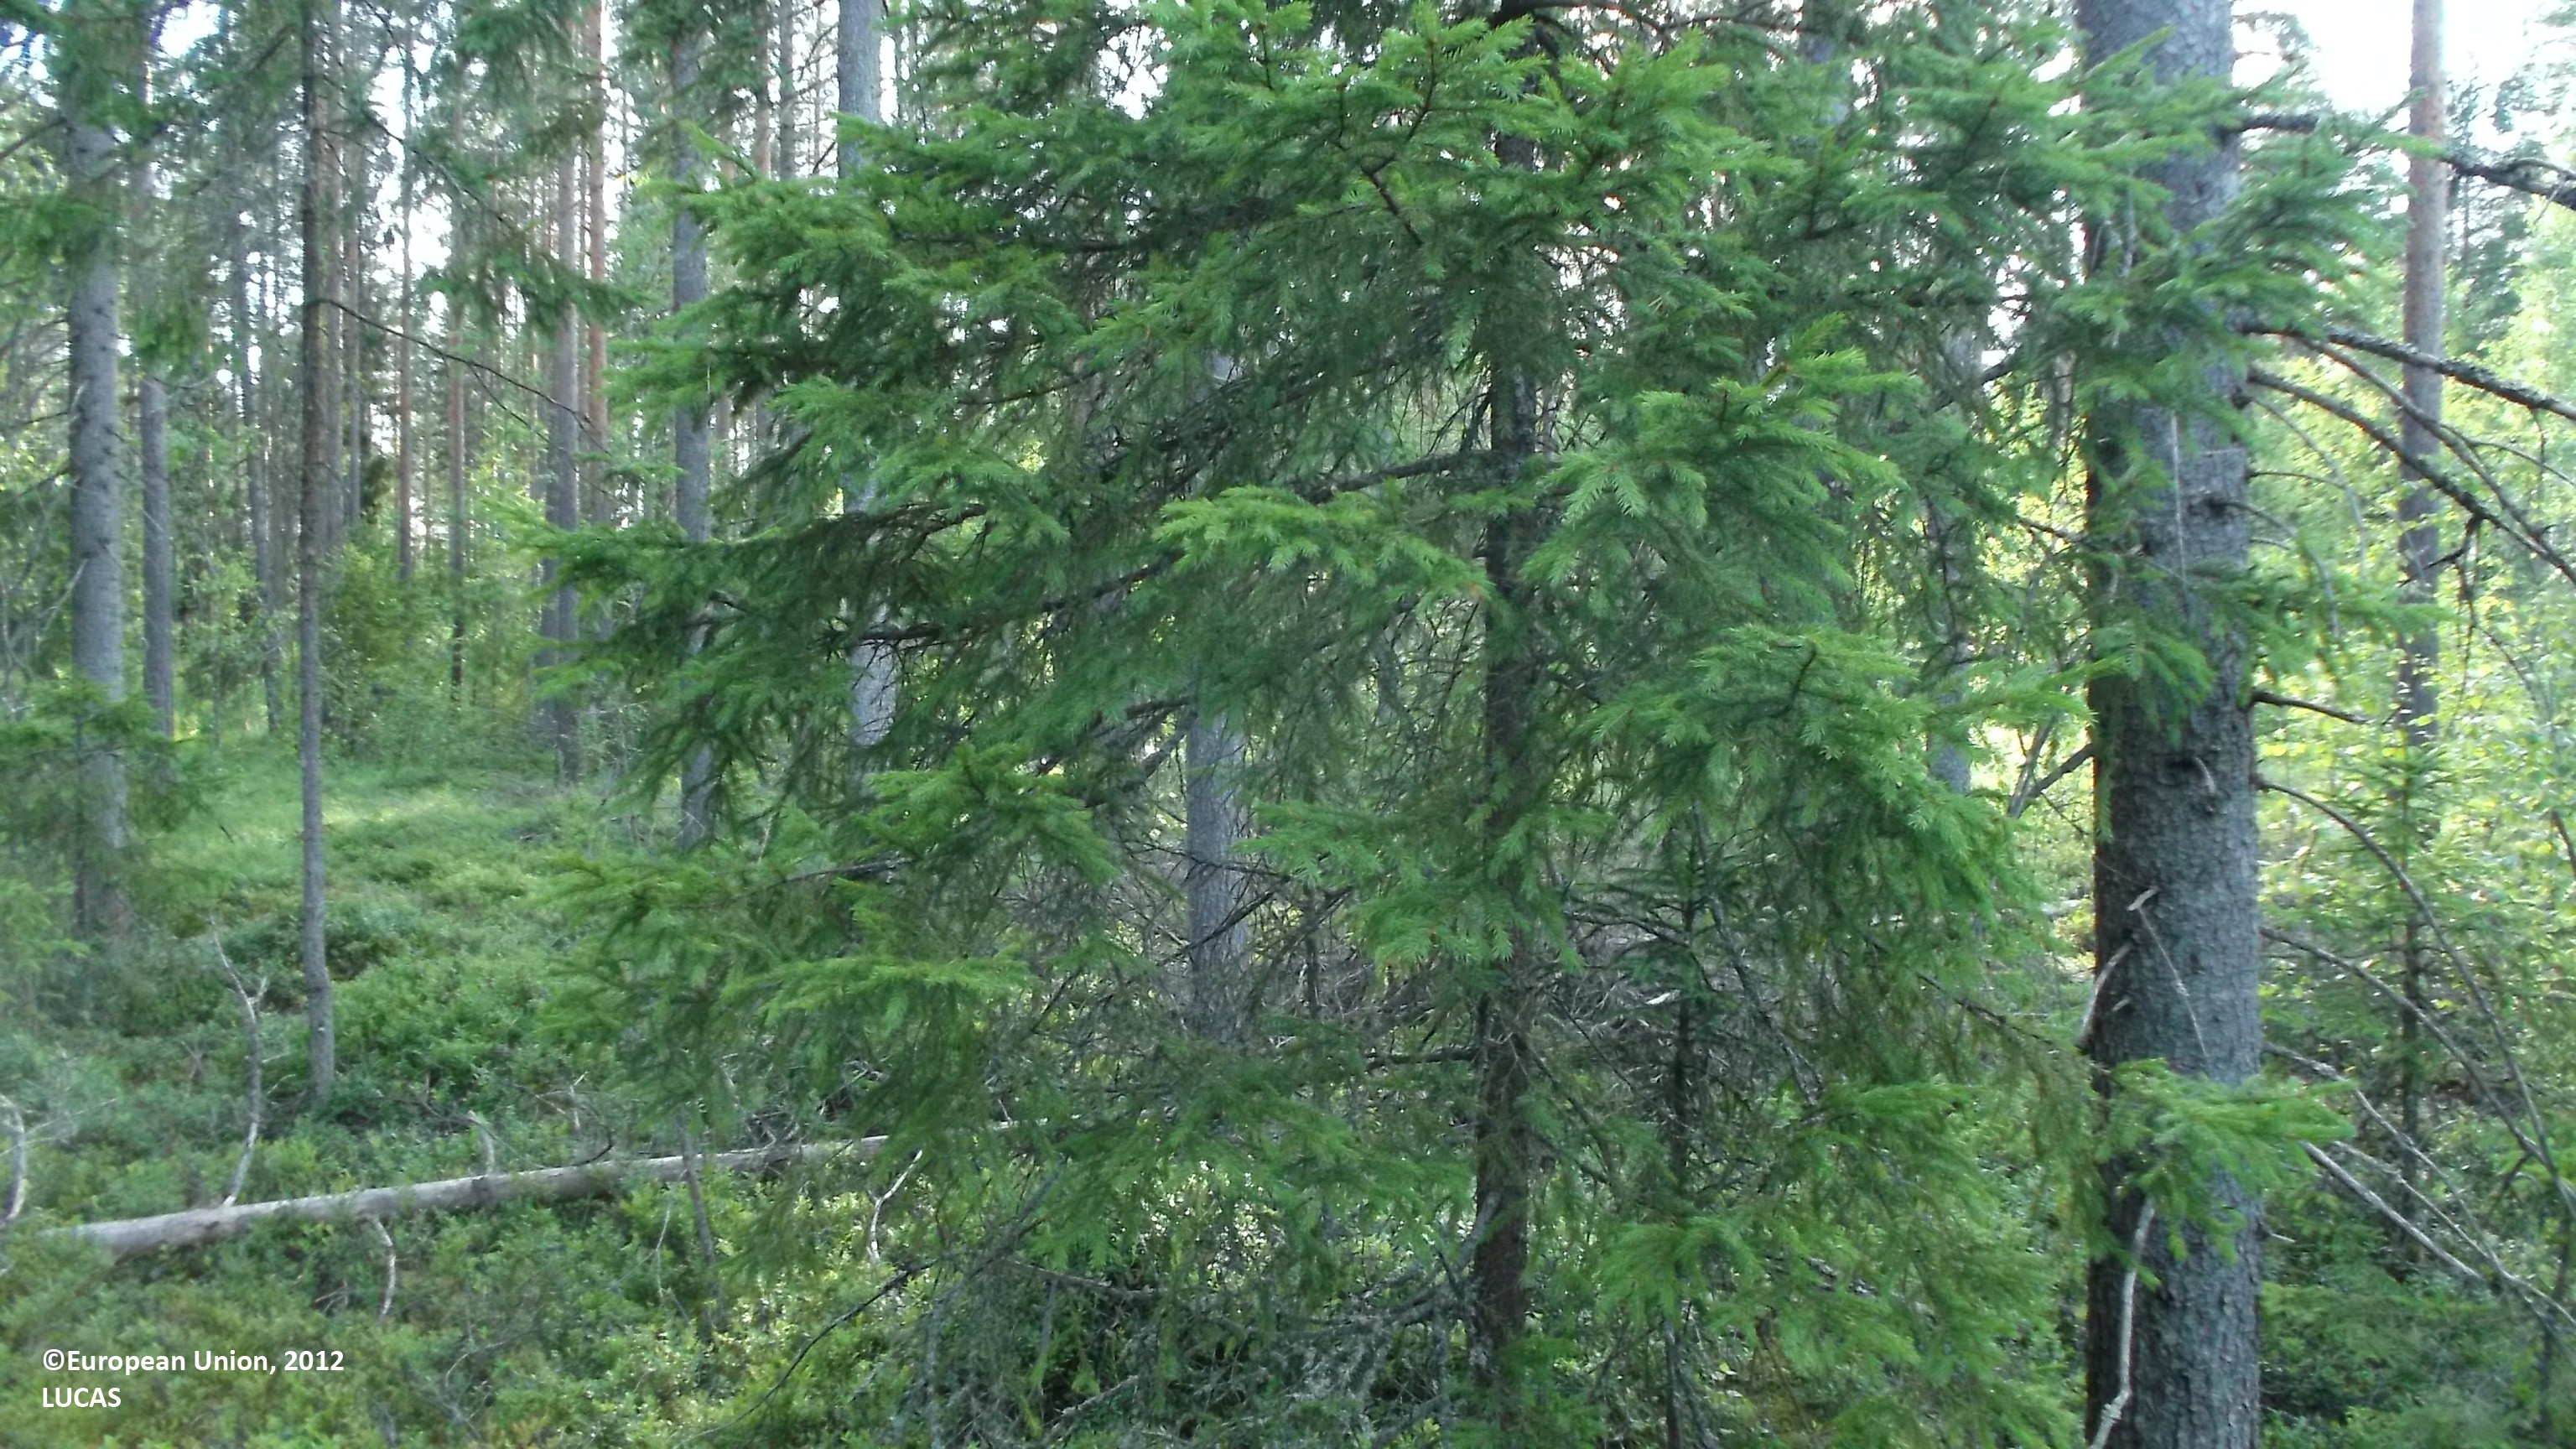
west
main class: Woodland
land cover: Other coniferous woodland
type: boreal forest
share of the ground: 25 - 50 %
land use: Forestry
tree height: > 5 m
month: July
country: FI
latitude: 63.2026
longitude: 23.8081
